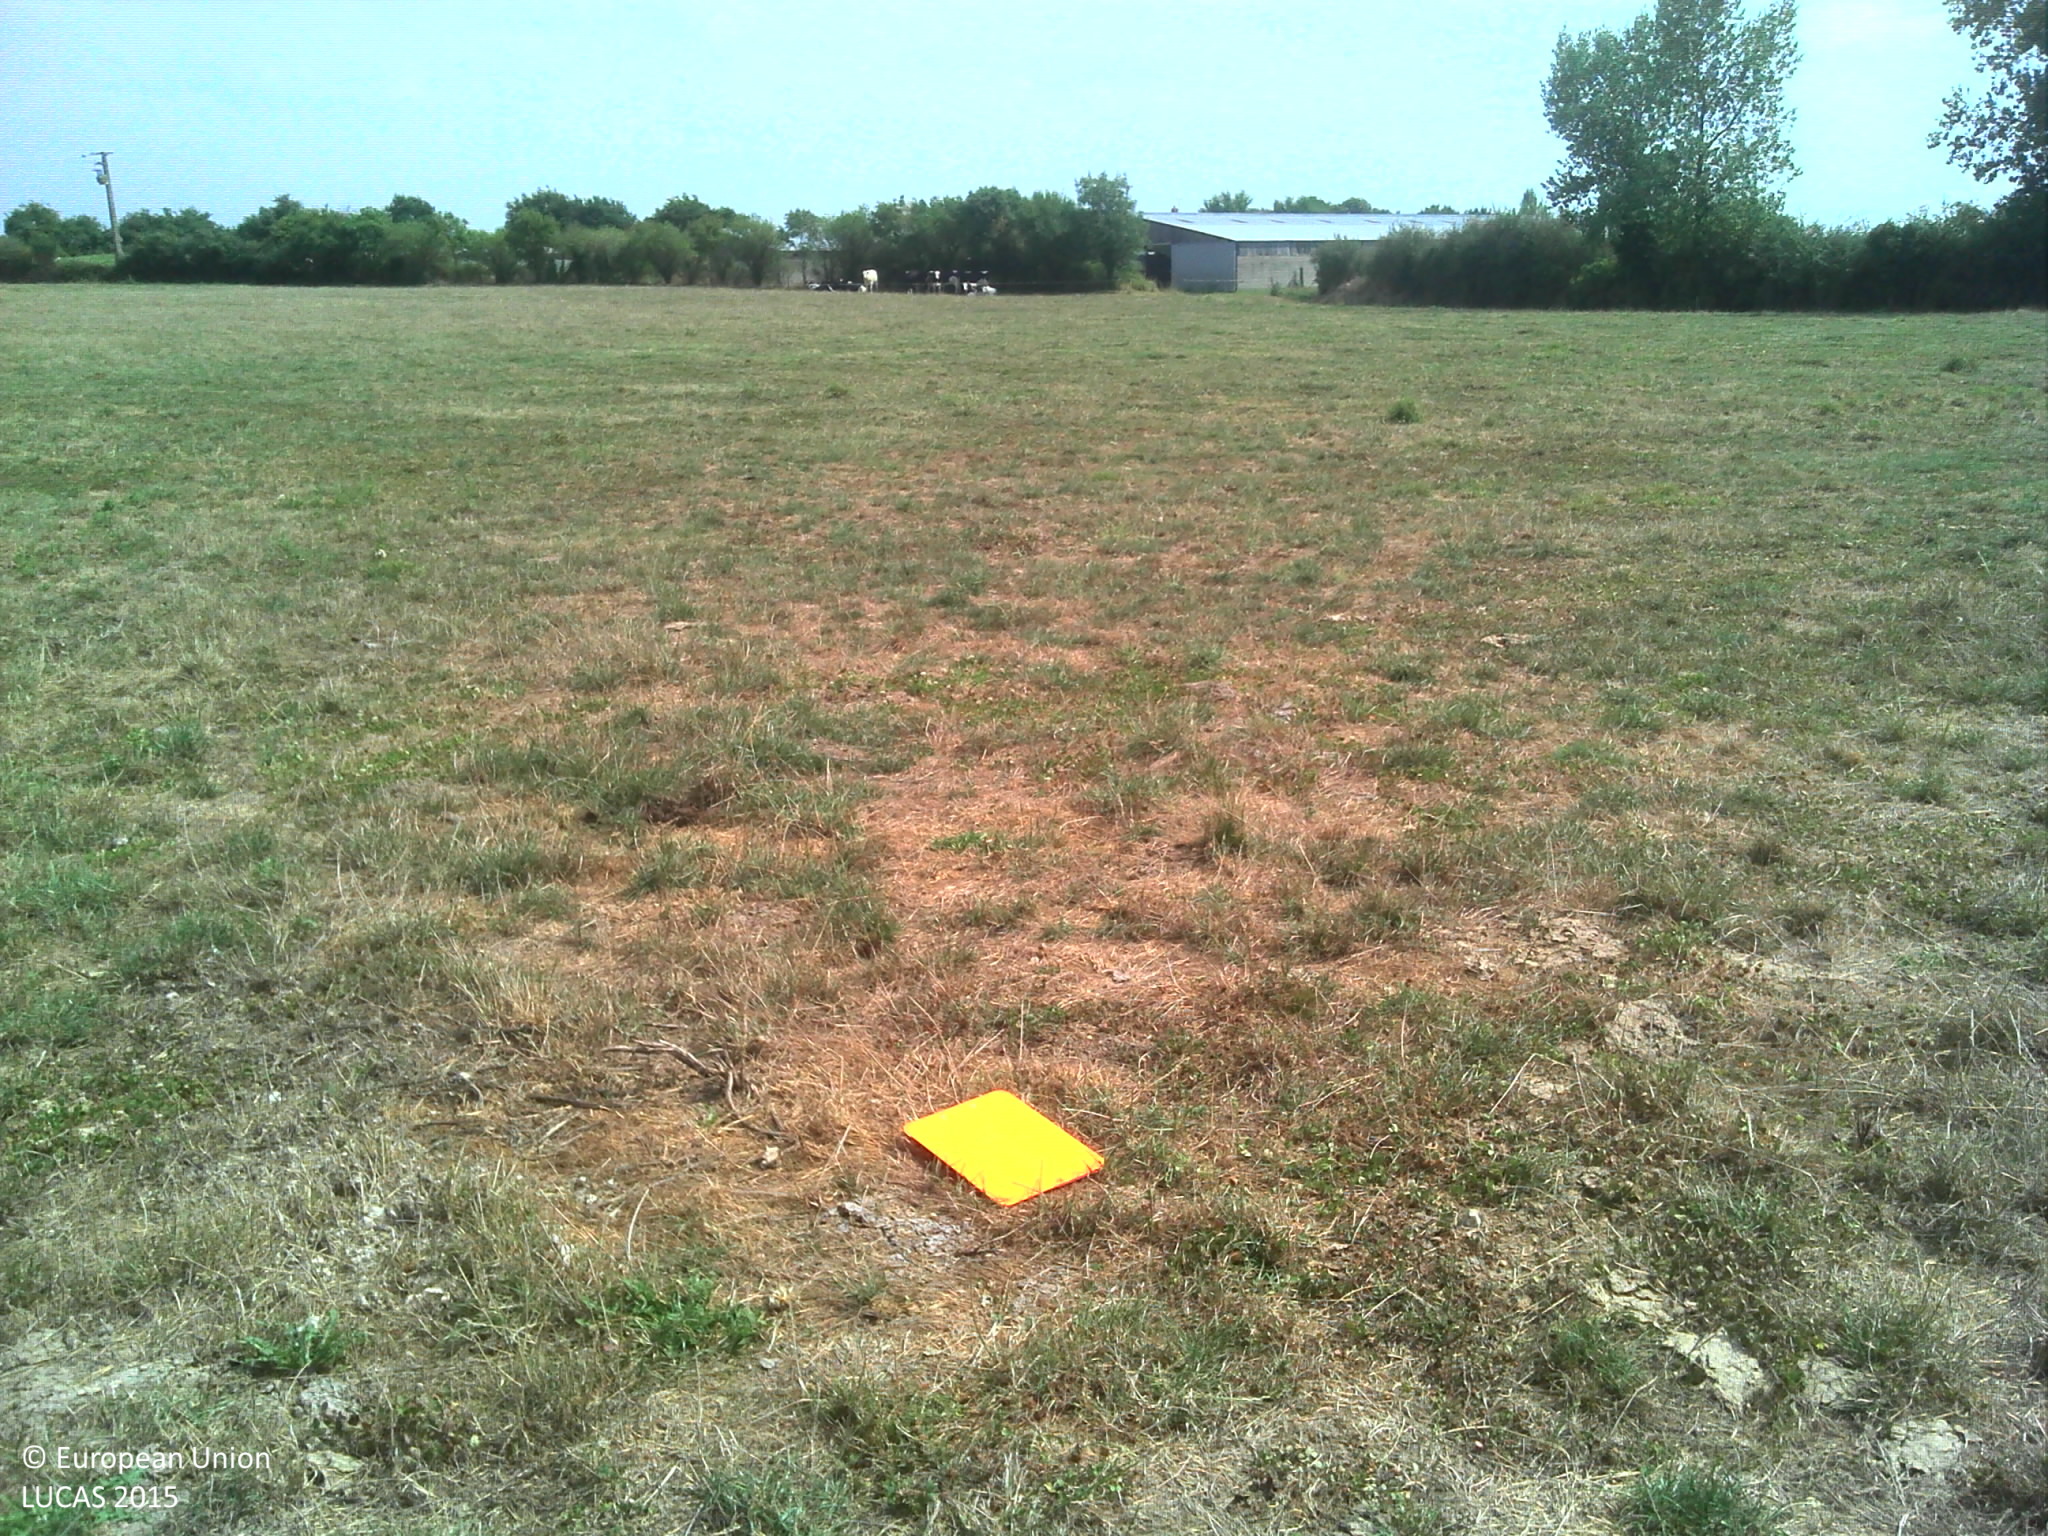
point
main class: Grassland
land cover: Grassland without tree/shrub cover
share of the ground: > 75 %
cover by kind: herbaceous plants 100 %
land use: Agriculture (excluding fallow land and kitchen gardens)
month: August
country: FR
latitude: 46.6785
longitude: -1.7952
